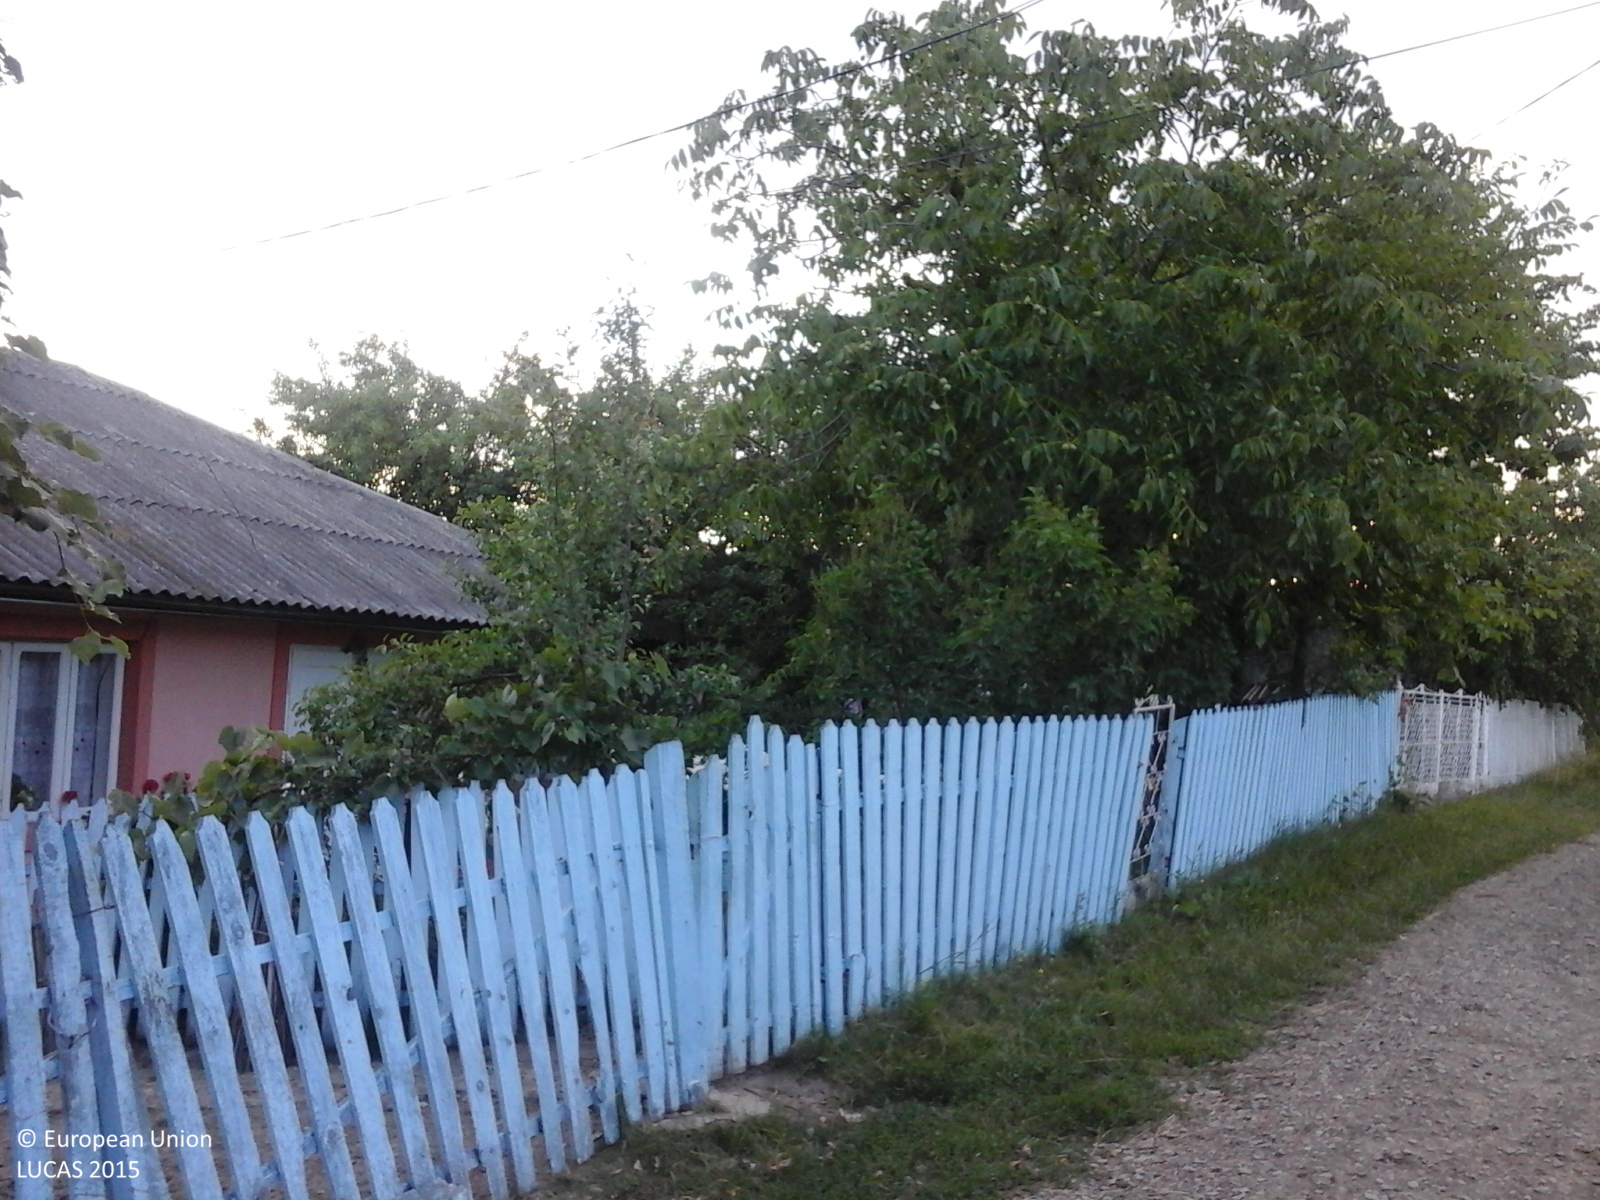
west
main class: Grassland
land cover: Grassland without tree/shrub cover
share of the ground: > 75 %
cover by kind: herbaceous plants 100 %
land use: Agriculture (excluding fallow land and kitchen gardens)
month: June
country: RO
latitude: 48.2015
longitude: 26.6054
